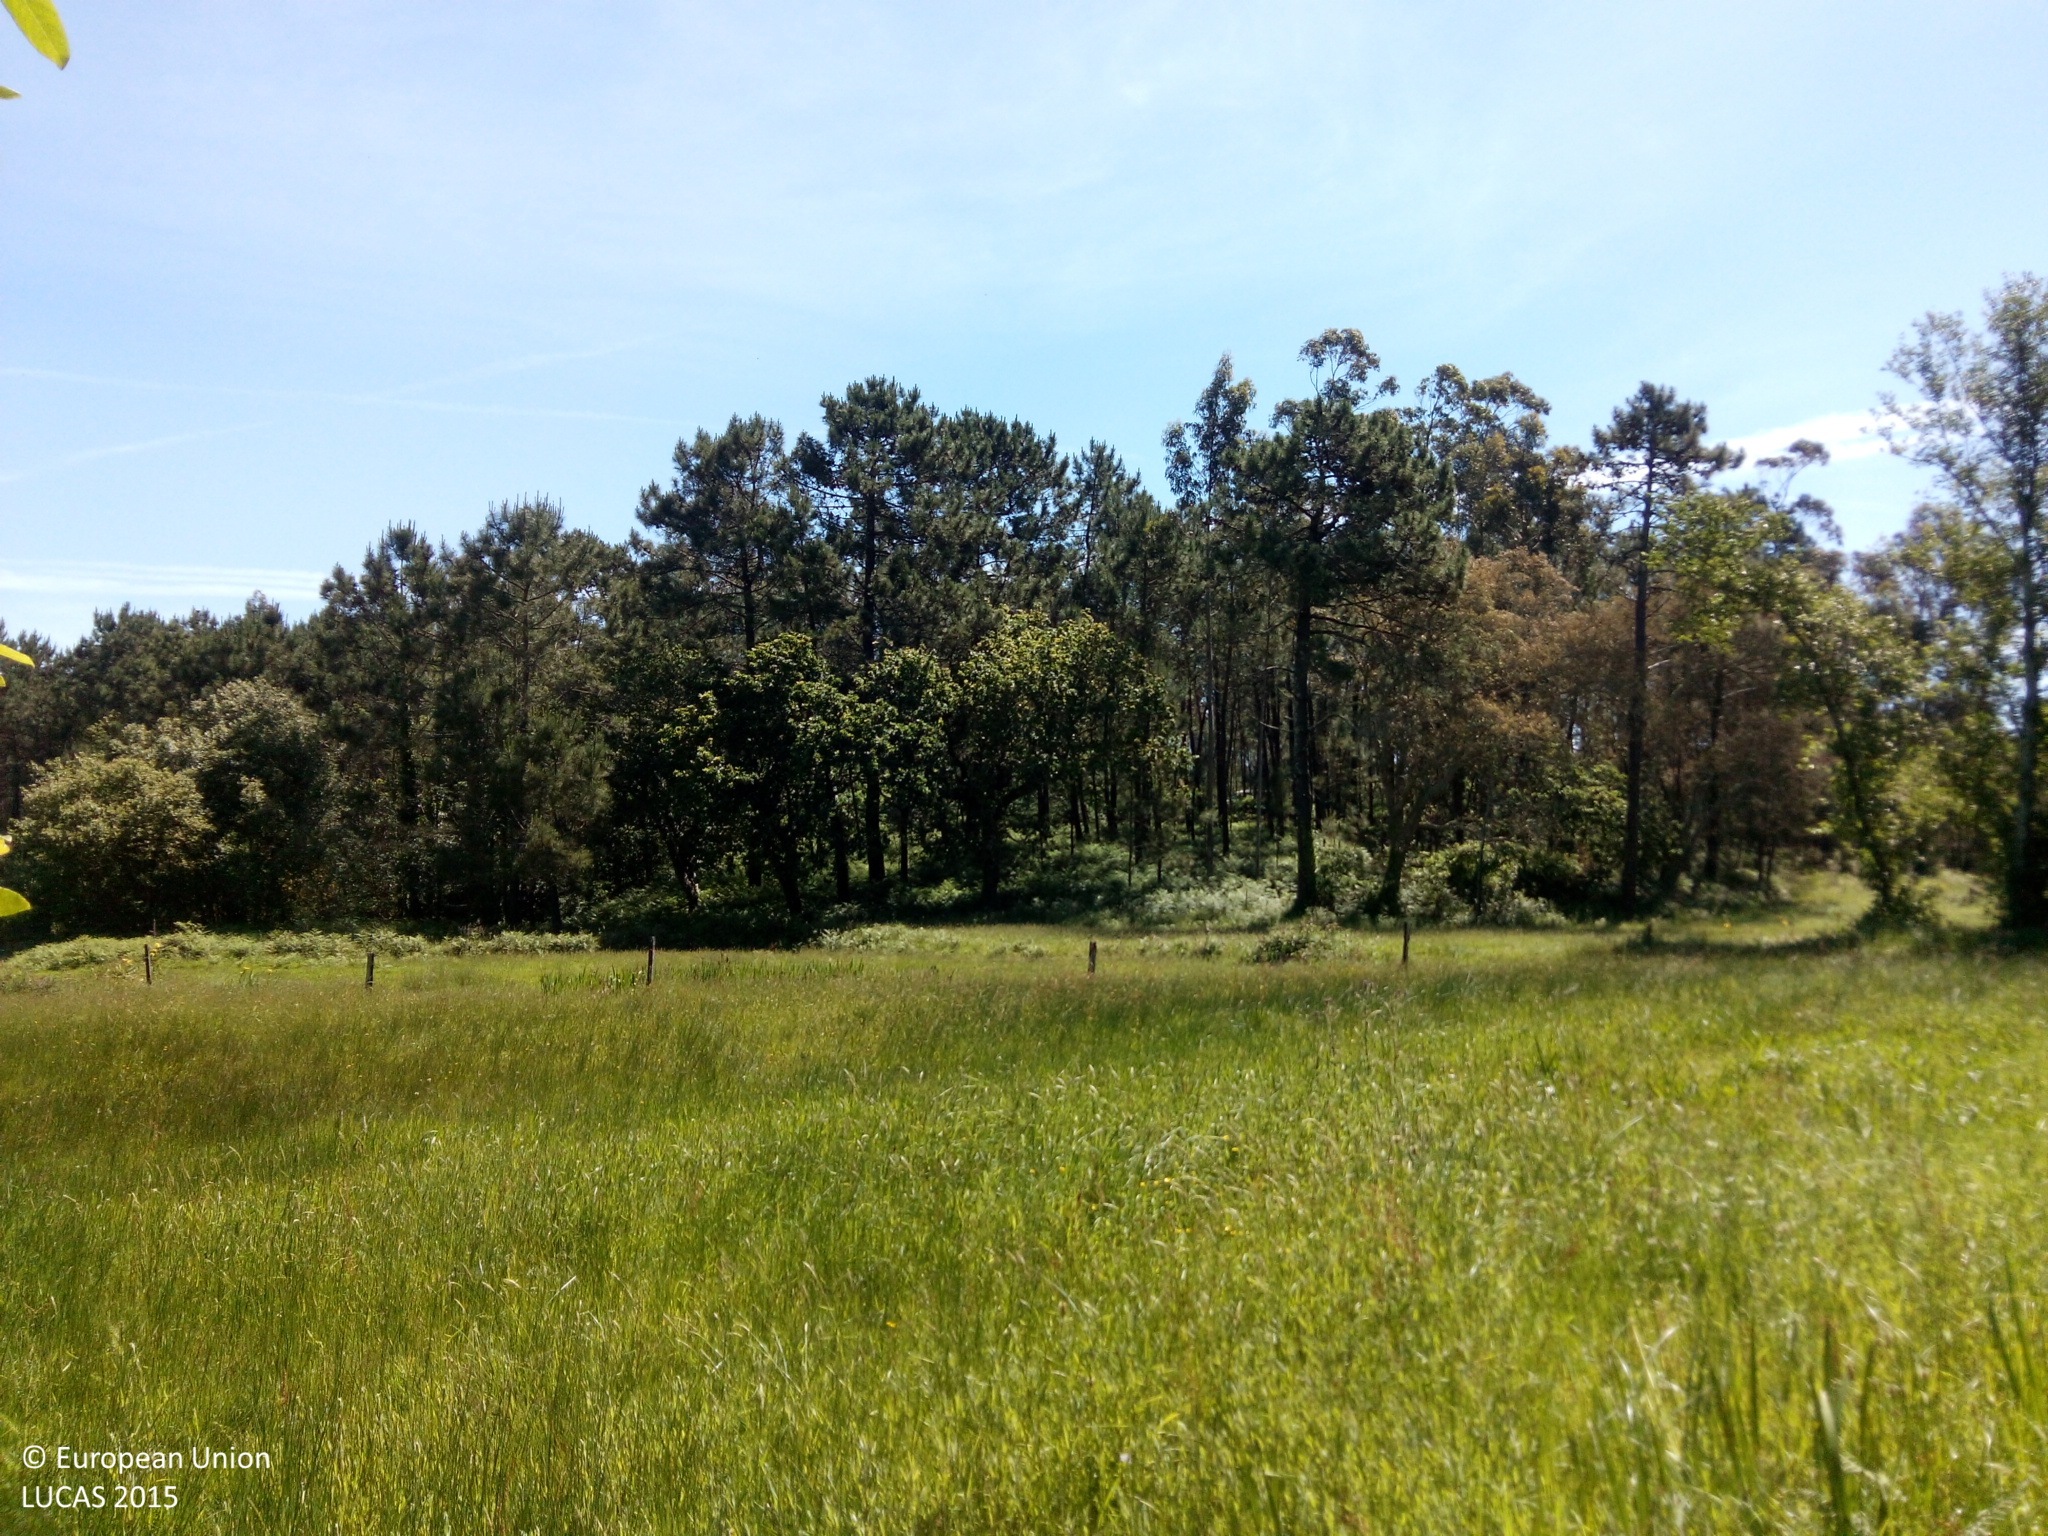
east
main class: Woodland
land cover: Broadleaved woodland
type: thermophilous deciduous forest
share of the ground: > 75 %
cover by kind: broadleaved forest trees 100 %
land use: Forestry
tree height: > 5 m
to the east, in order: Broadleaved woodland; Grassland without tree/shrub cover; Rivers and streams; Spontaneously vegetated surfaces; Rivers and streams; Fences; Spontaneously vegetated surfaces; Fences; Spontaneously vegetated surfaces; Pine dominated coniferous woodland; Tracks; Pine dominated coniferous woodland; Paved roads, cycling and walking lanes; Ditches and canals; Artificial constructions; Pine dominated coniferous woodland; Pine dominated mixed woodland; Pine dominated coniferous woodland
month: May
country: ES
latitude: 42.6251
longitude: -9.0279
